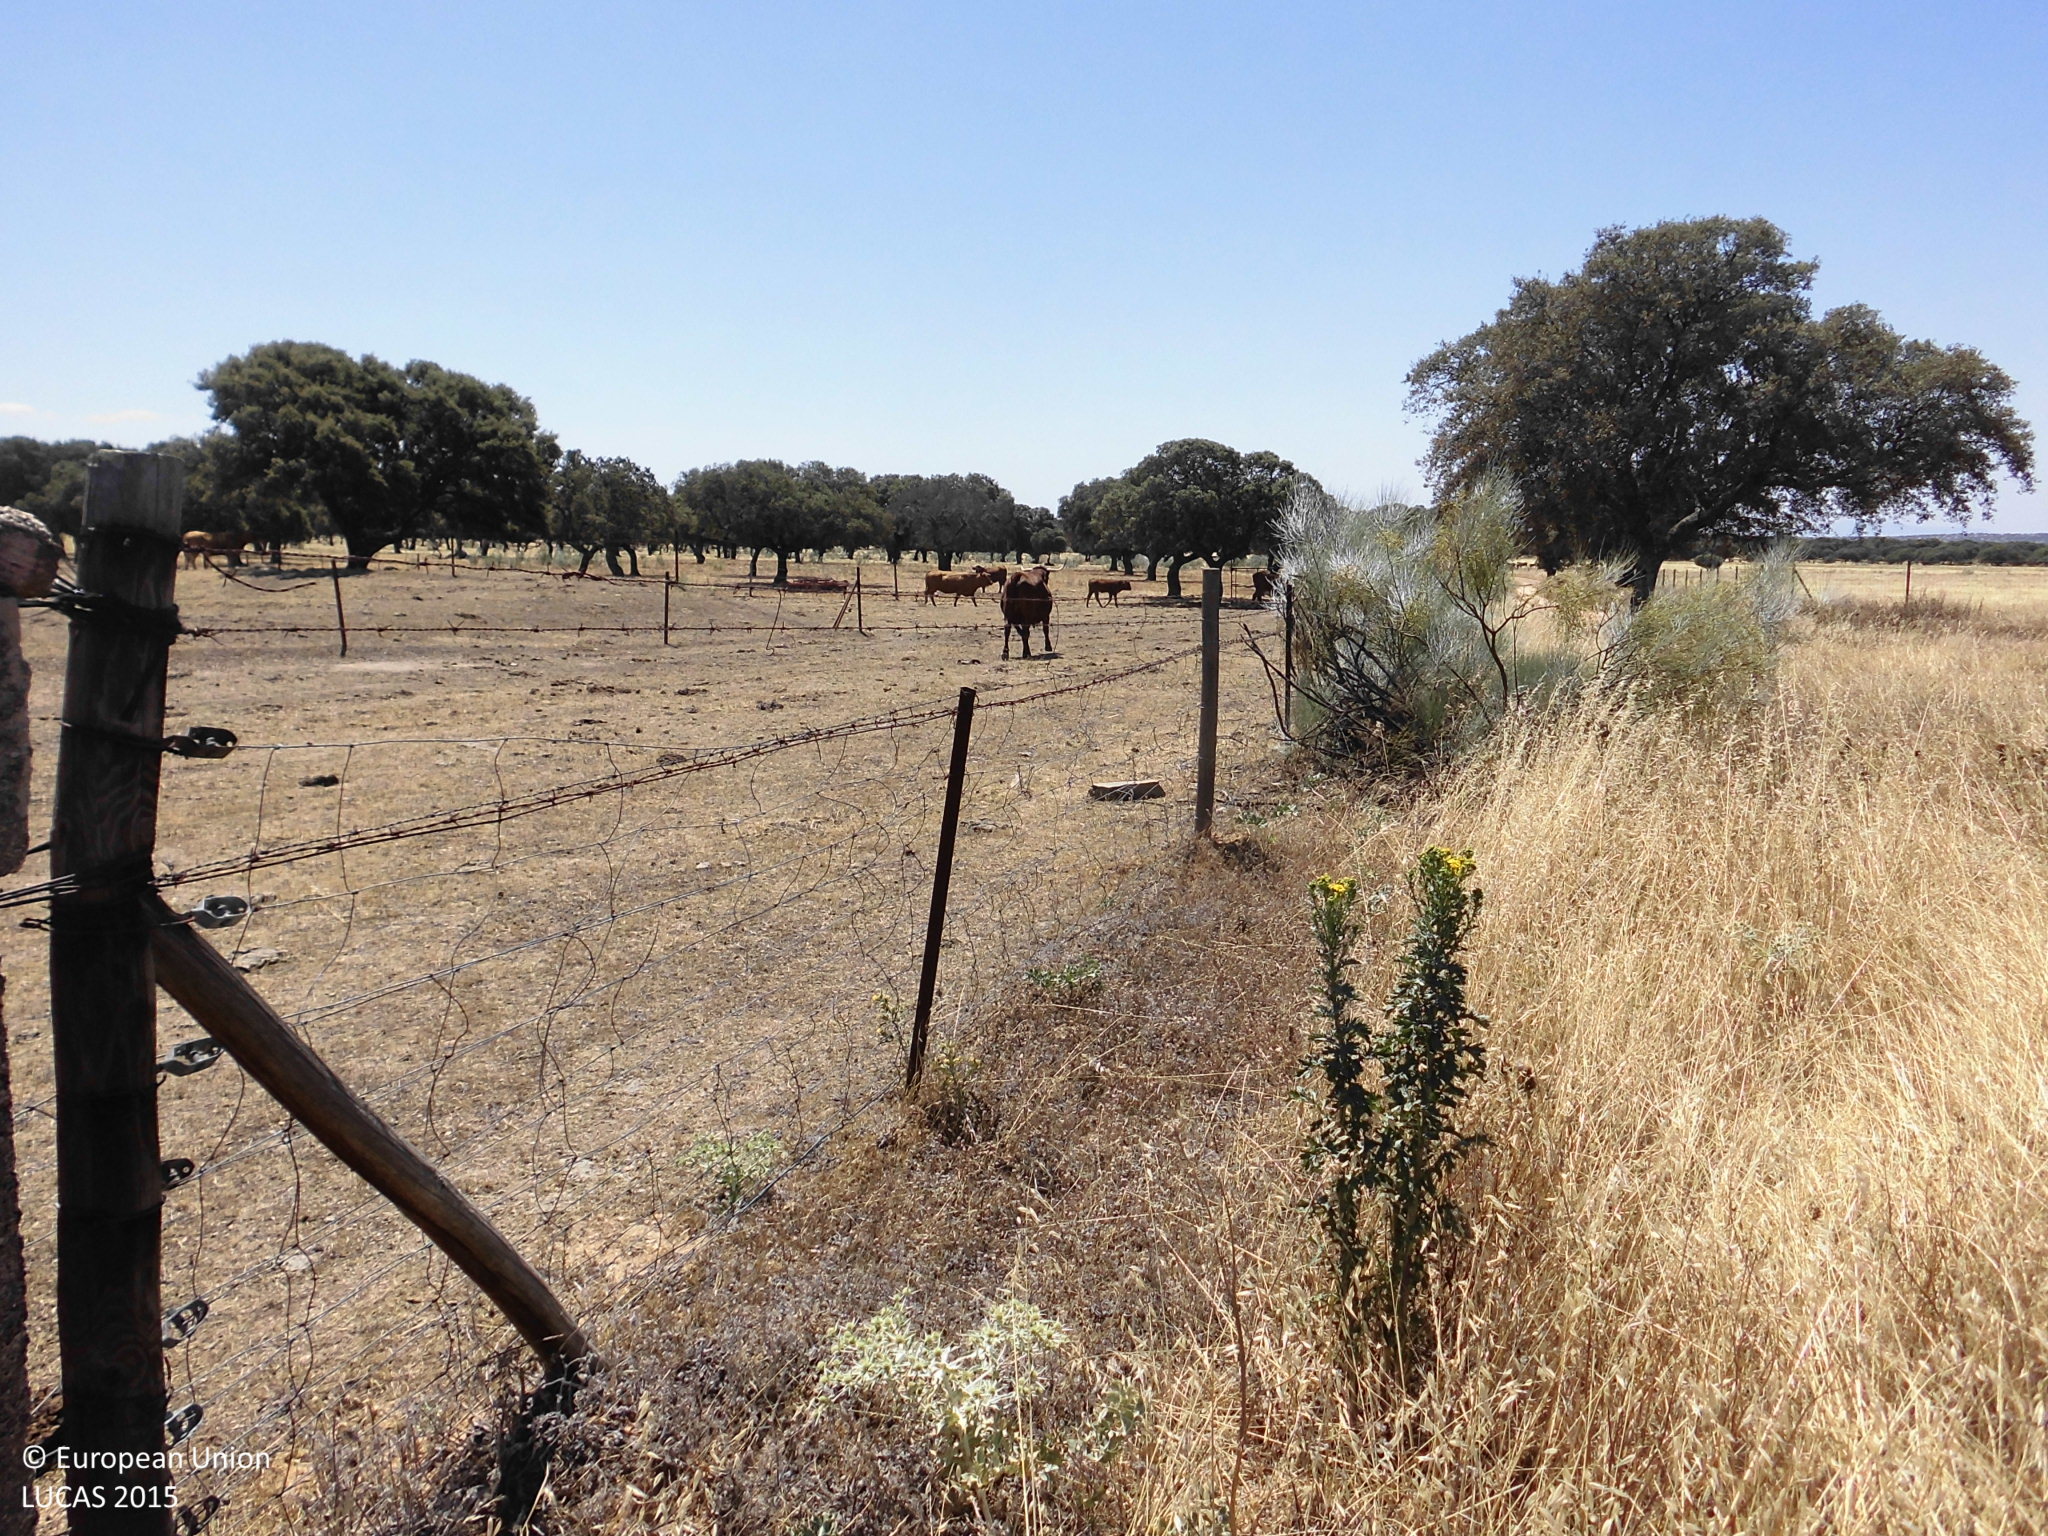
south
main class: Woodland
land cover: Broadleaved woodland
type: broadleaved evergreen forest
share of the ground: 10 - 25 %
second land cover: Grassland without tree/shrub cover
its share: > 75 %
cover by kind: herbaceous plants 75 %, broadleaved forest trees 25 %
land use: Forestry
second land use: Agriculture (excluding fallow land and kitchen gardens)
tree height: > 5 m
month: June
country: ES
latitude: 39.6981
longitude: -6.0065
